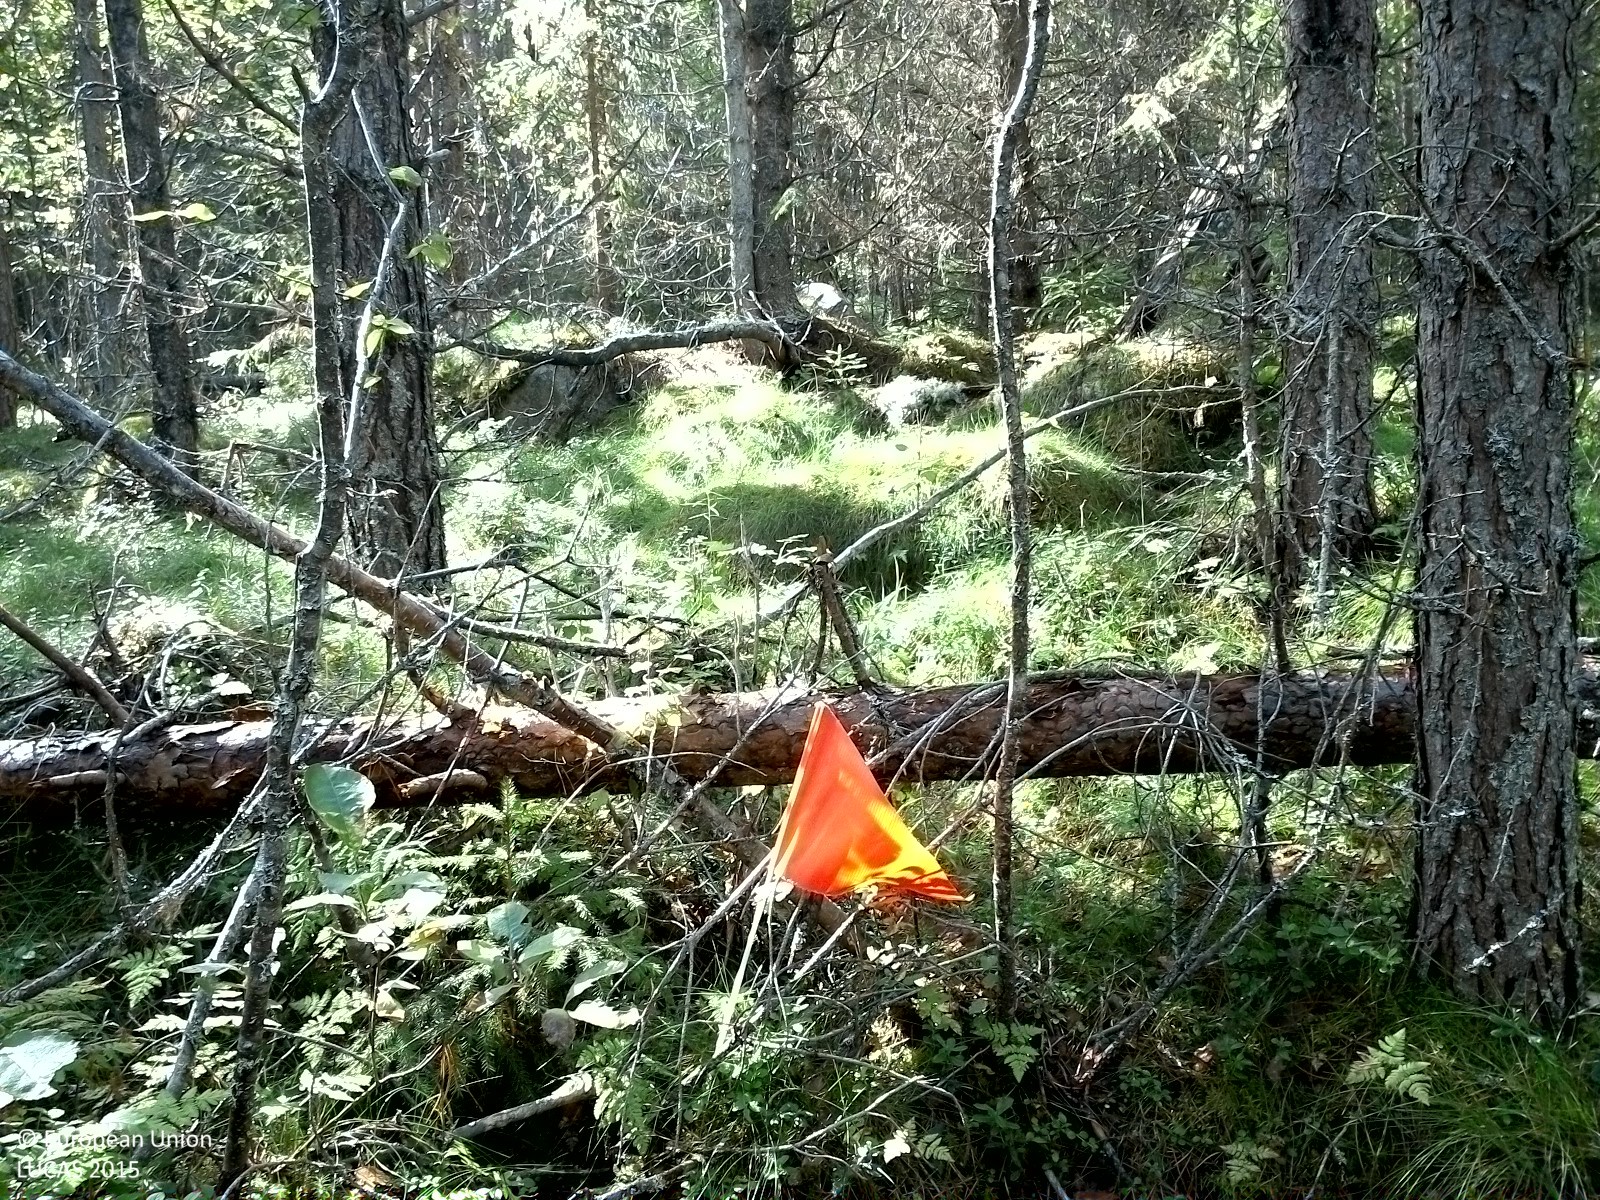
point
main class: Woodland
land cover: Pine dominated coniferous woodland
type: exotic forest
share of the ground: 50 - 75 %
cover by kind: coniferous forest trees 70 %, shrubs 10 %, herbaceous plants 10 %, lichens and mosses 10 %
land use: Forestry
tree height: > 5 m
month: September
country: SE
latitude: 62.5676
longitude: 16.3801
